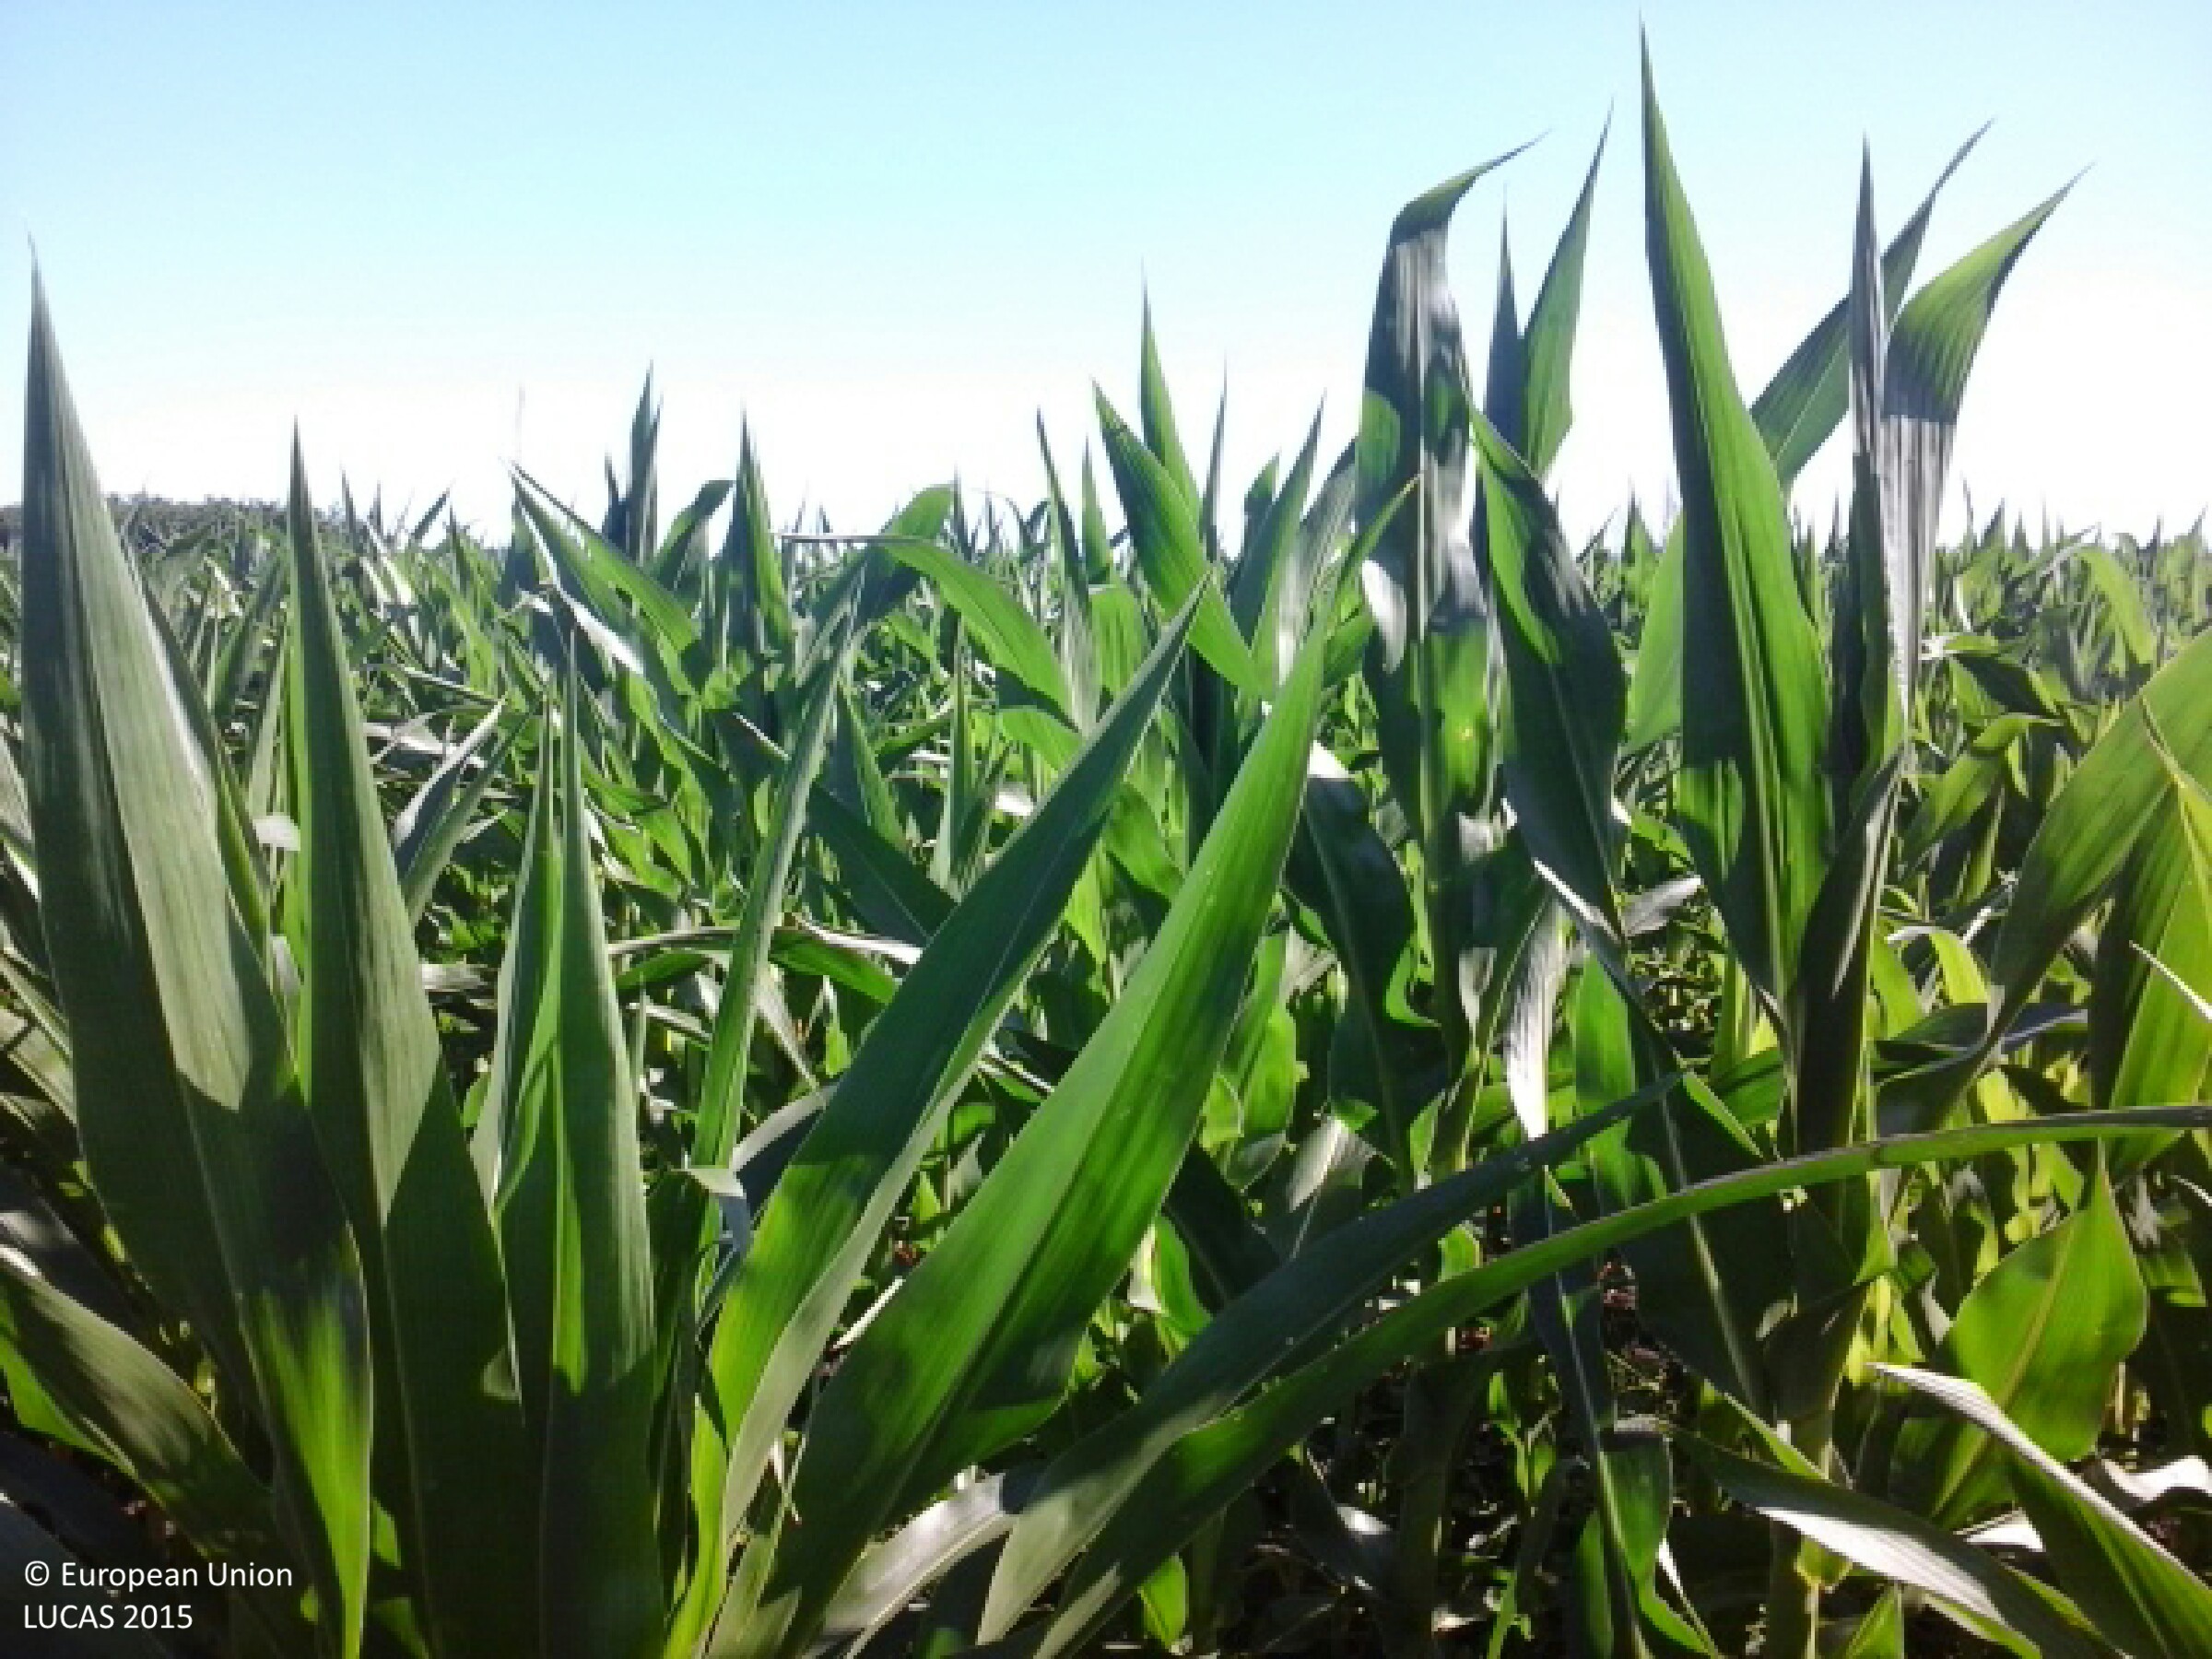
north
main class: Cropland
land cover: Maize
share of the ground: > 75 %
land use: Agriculture (excluding fallow land and kitchen gardens)
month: July
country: HU
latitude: 48.2033
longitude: 21.9877
